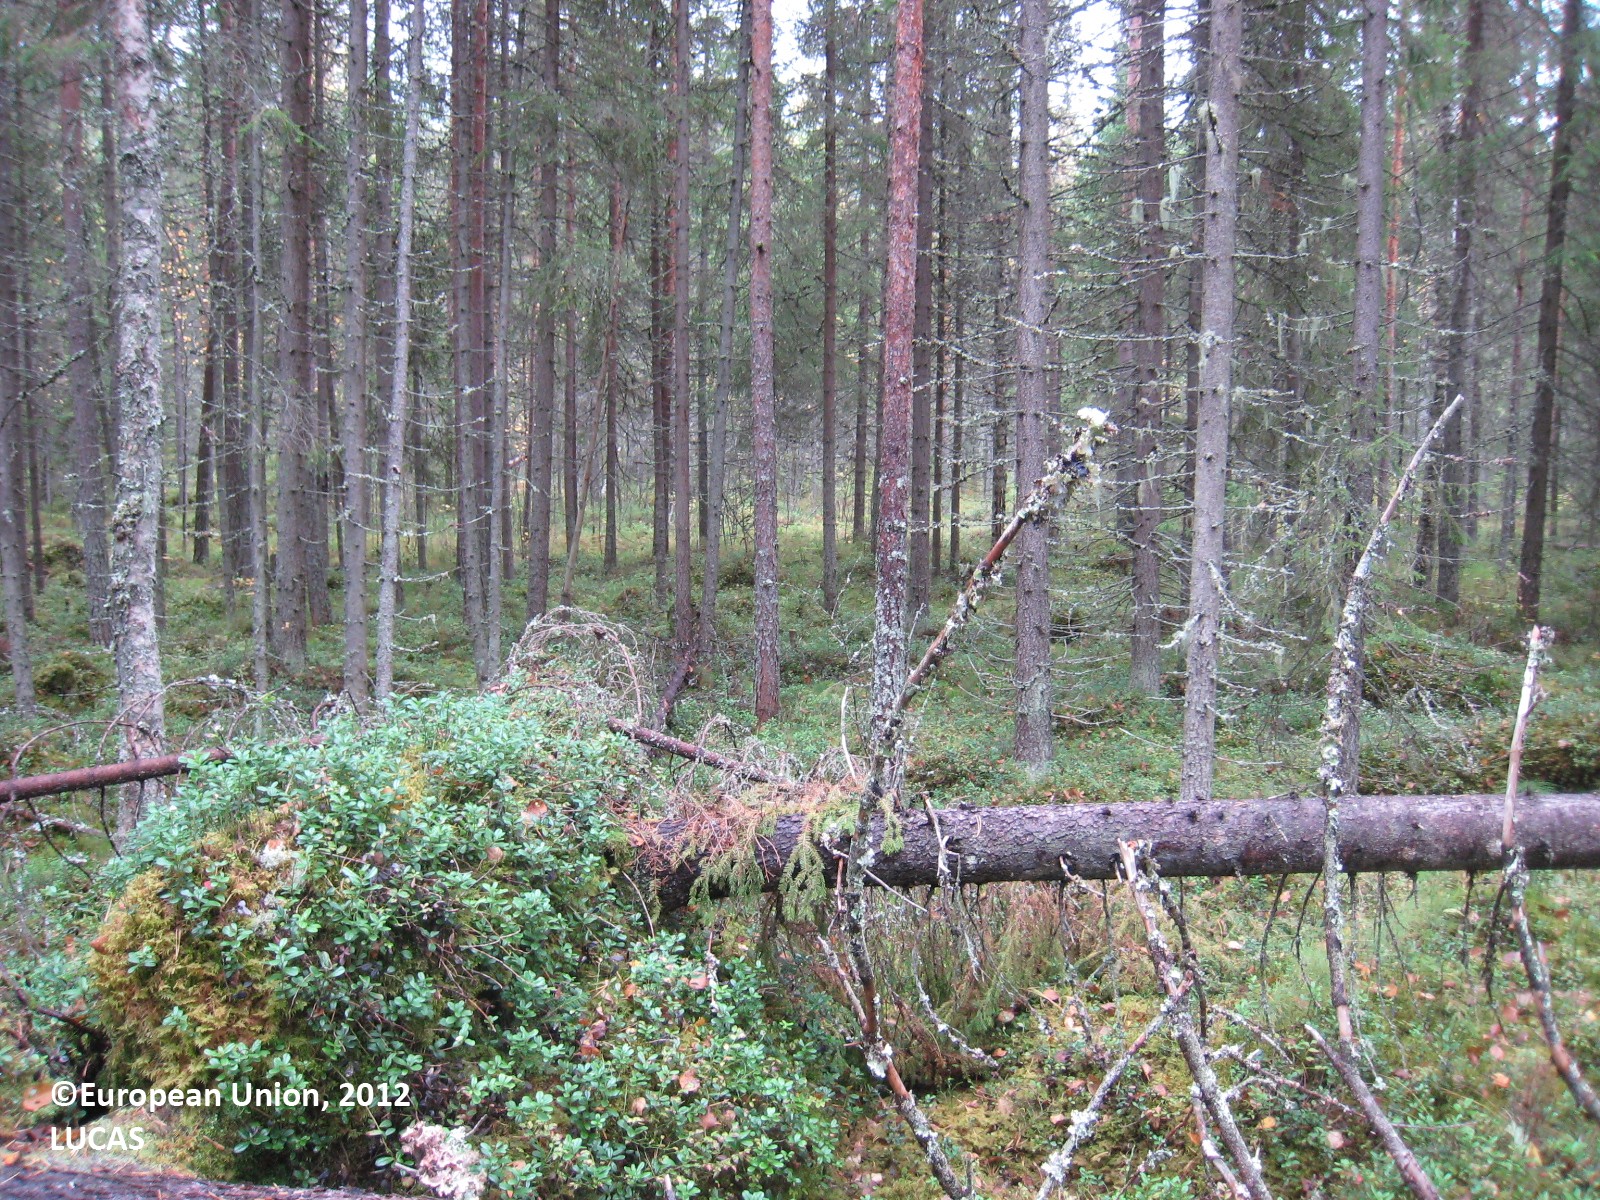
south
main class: Woodland
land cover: Other coniferous woodland
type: boreal forest
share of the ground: > 75 %
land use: Forestry
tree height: > 5 m
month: September
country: FI
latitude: 62.7258
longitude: 26.1859
